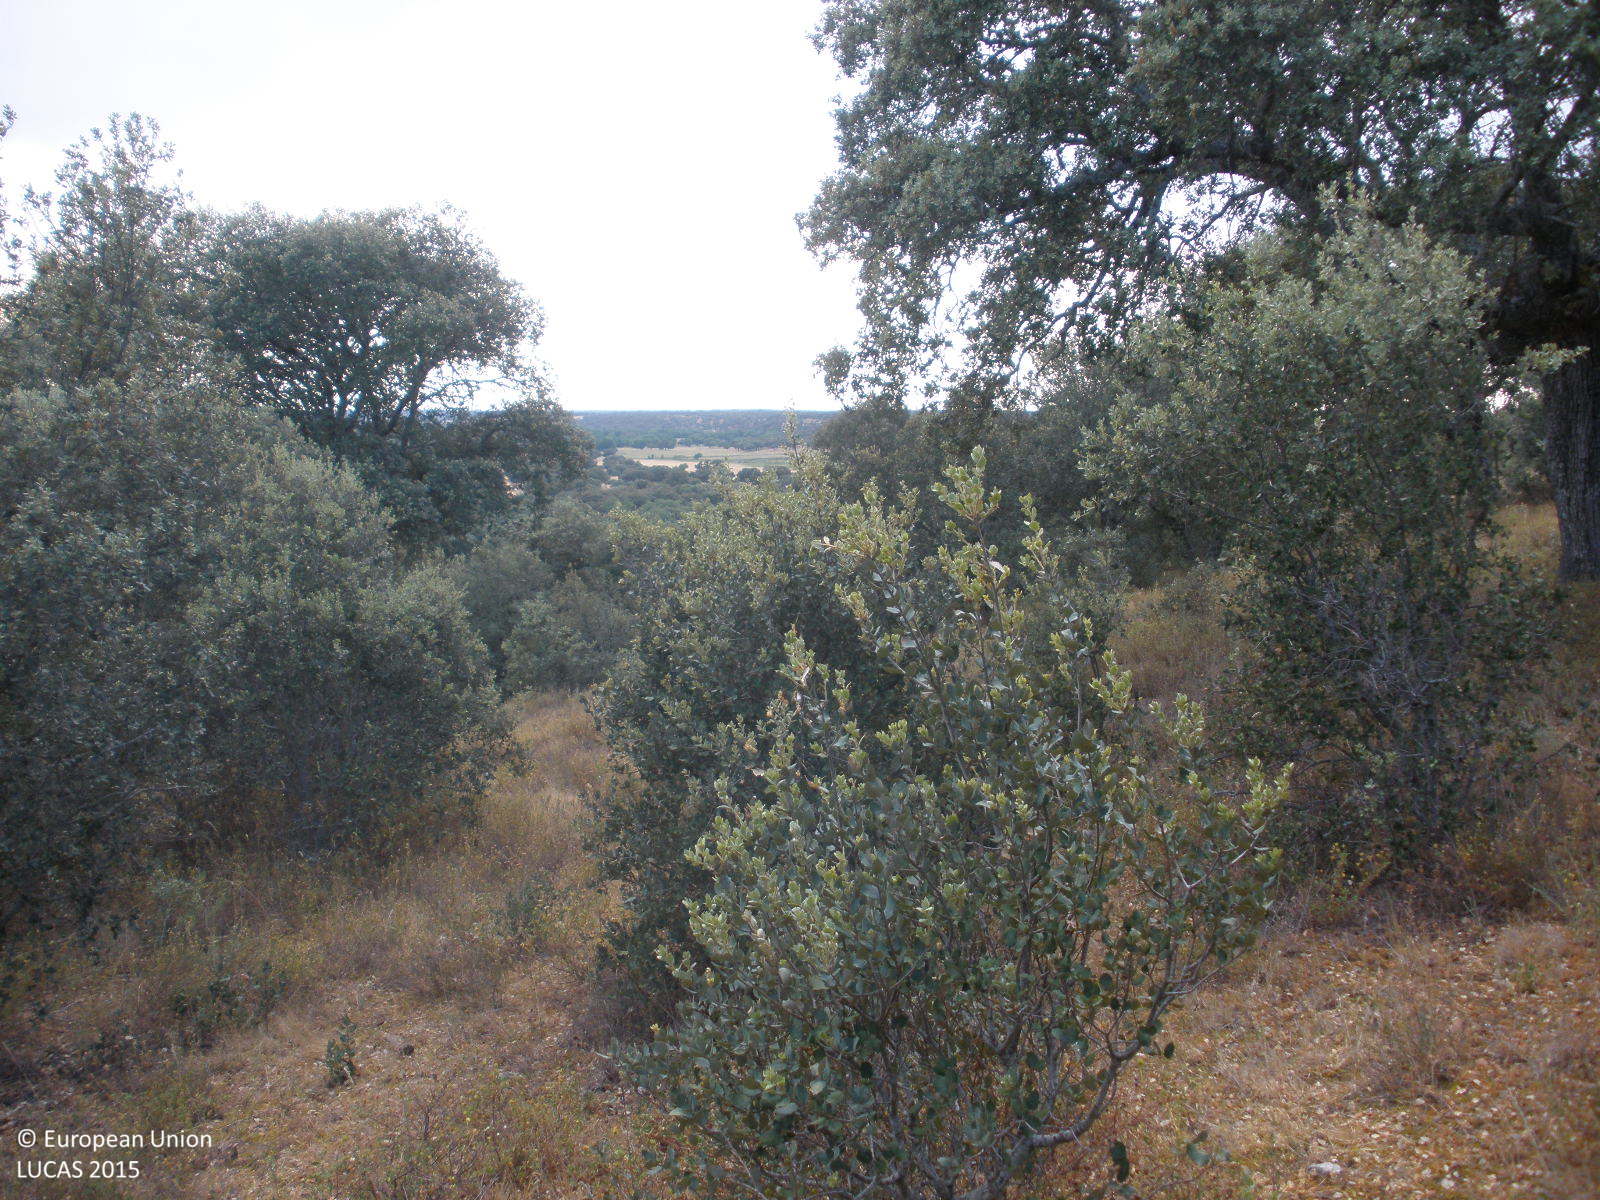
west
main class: Woodland
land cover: Broadleaved woodland
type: broadleaved evergreen forest
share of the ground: > 75 %
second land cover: Shrubland without tree cover
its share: 25 - 50 %
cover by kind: broadleaved forest trees 70 %, shrubs 30 %
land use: Forestry
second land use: Agriculture (excluding fallow land and kitchen gardens)
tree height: > 5 m
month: June
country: ES
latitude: 40.7505
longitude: -6.2047
